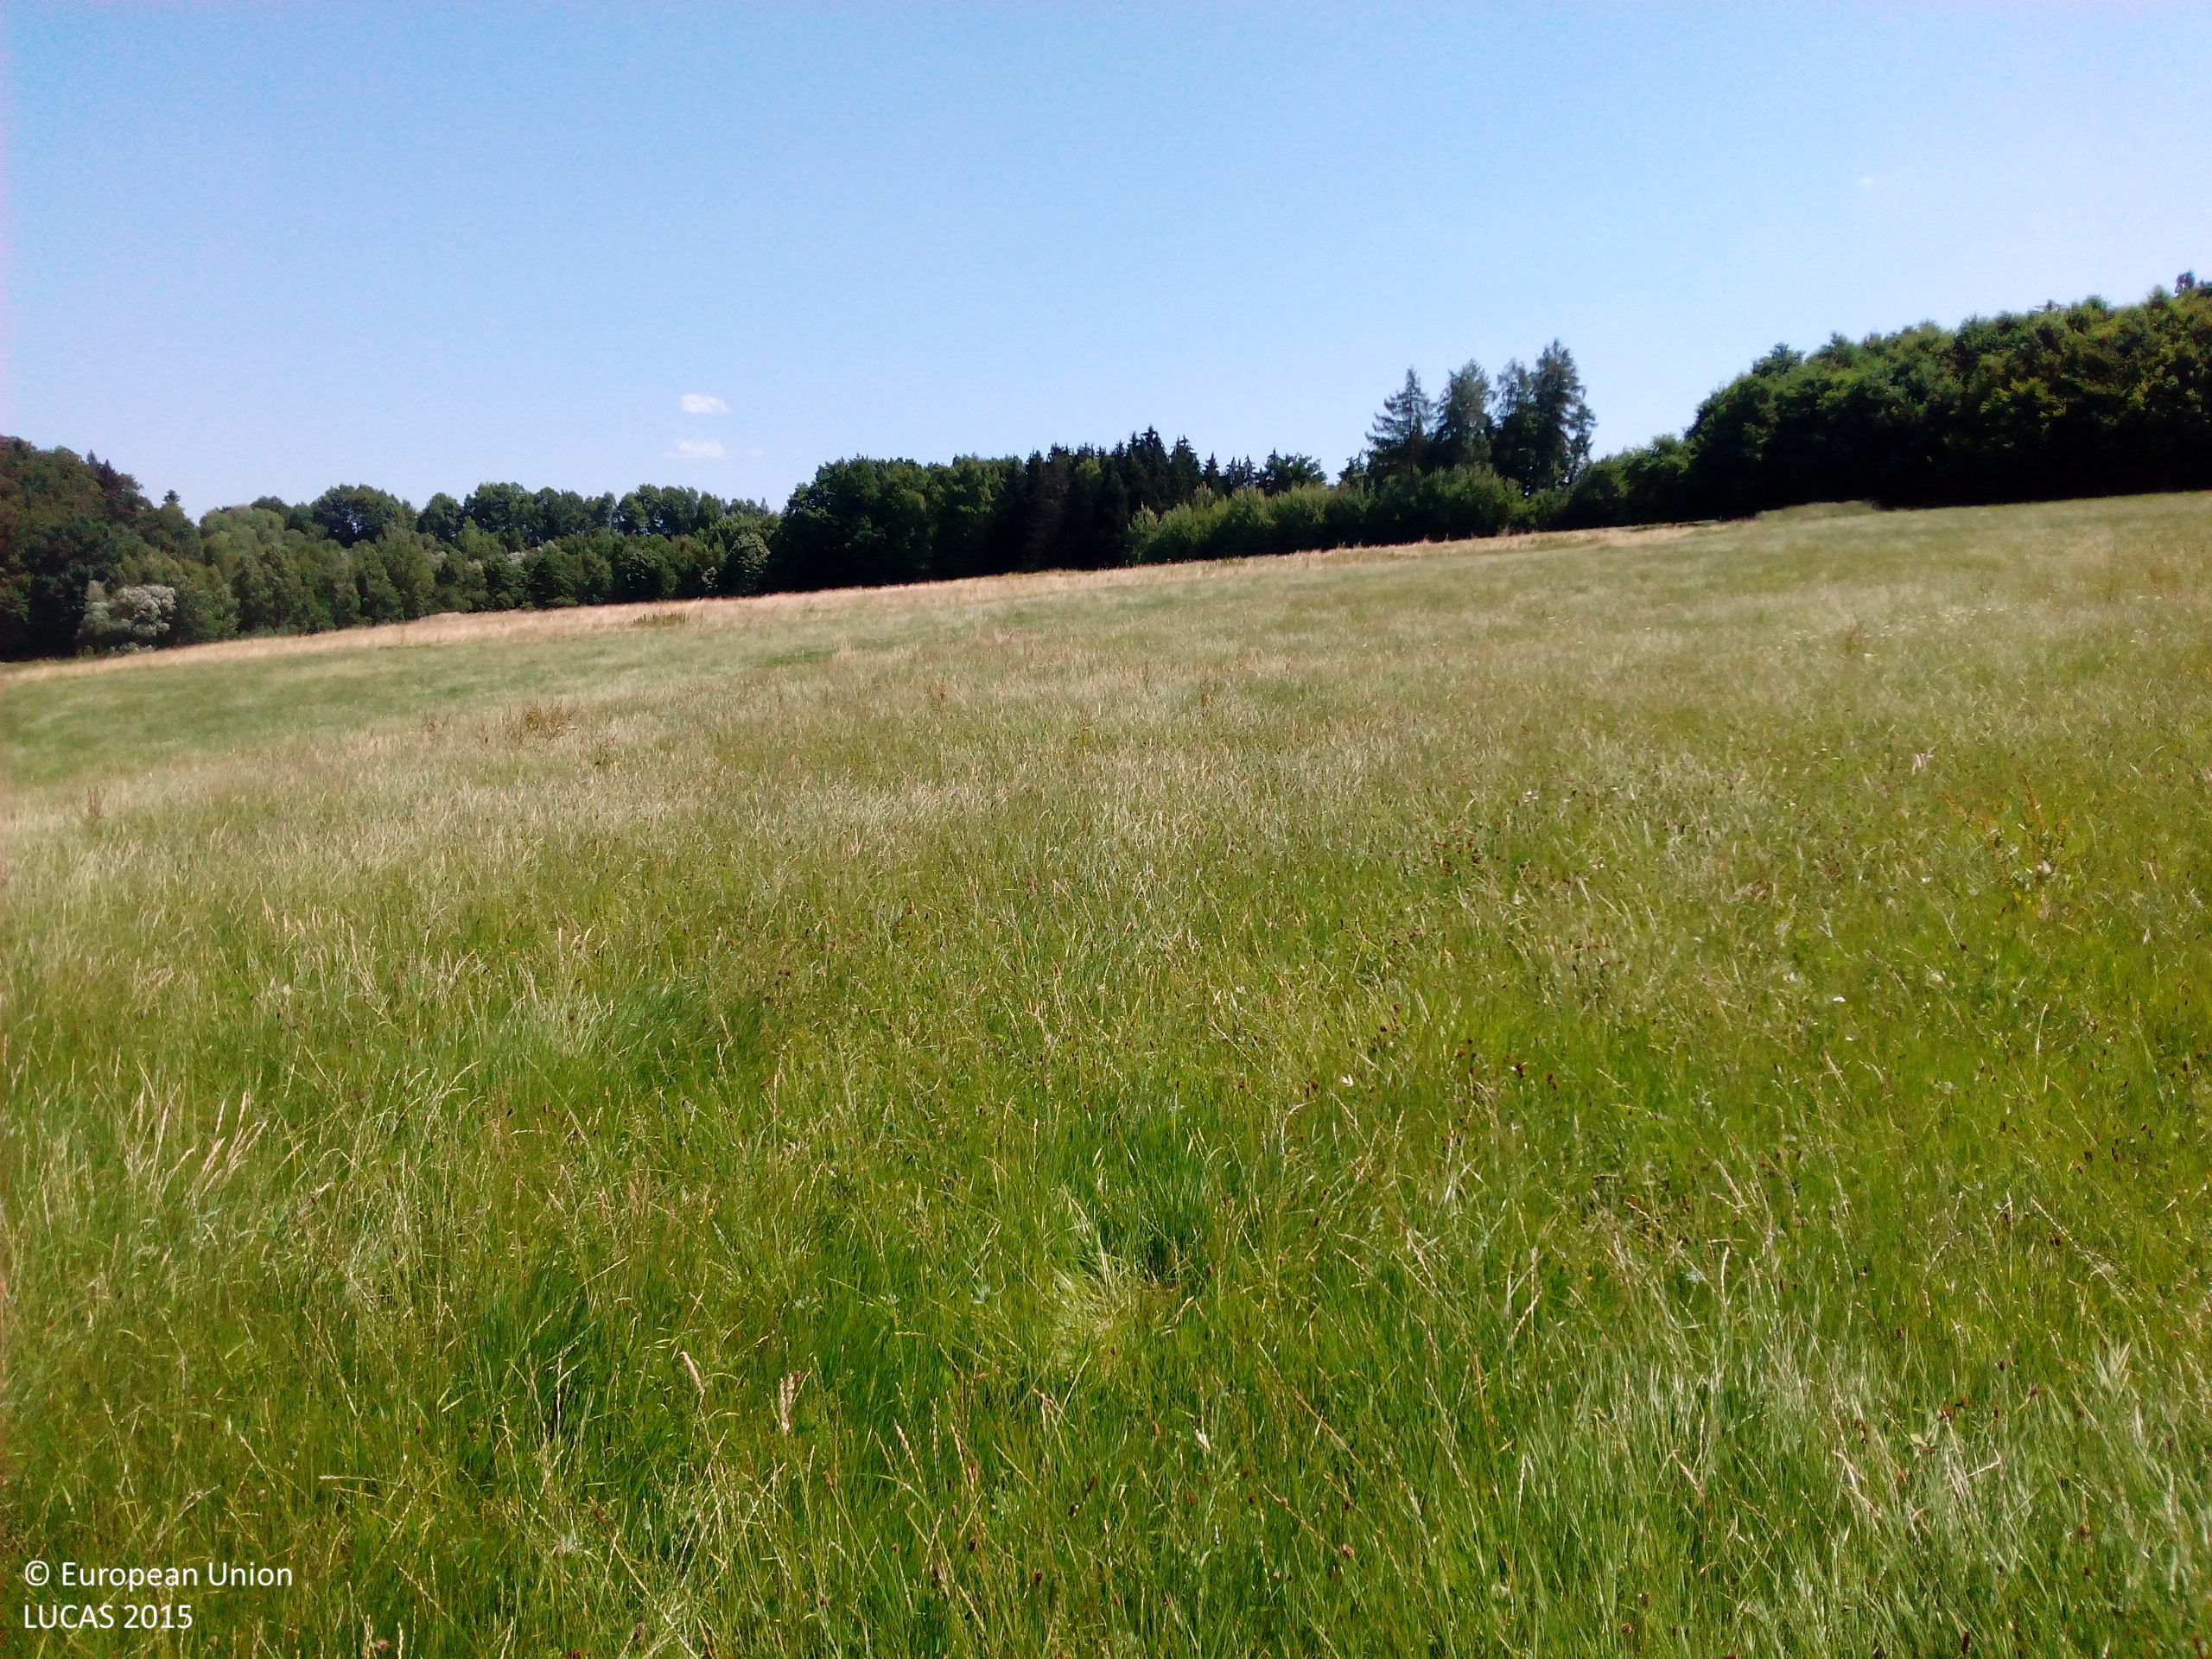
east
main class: Grassland
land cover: Grassland without tree/shrub cover
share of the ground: > 75 %
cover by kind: herbaceous plants 100 %
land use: Agriculture (excluding fallow land and kitchen gardens)
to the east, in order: Grassland without tree/shrub cover
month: July
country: DE
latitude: 48.5722
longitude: 13.2386
